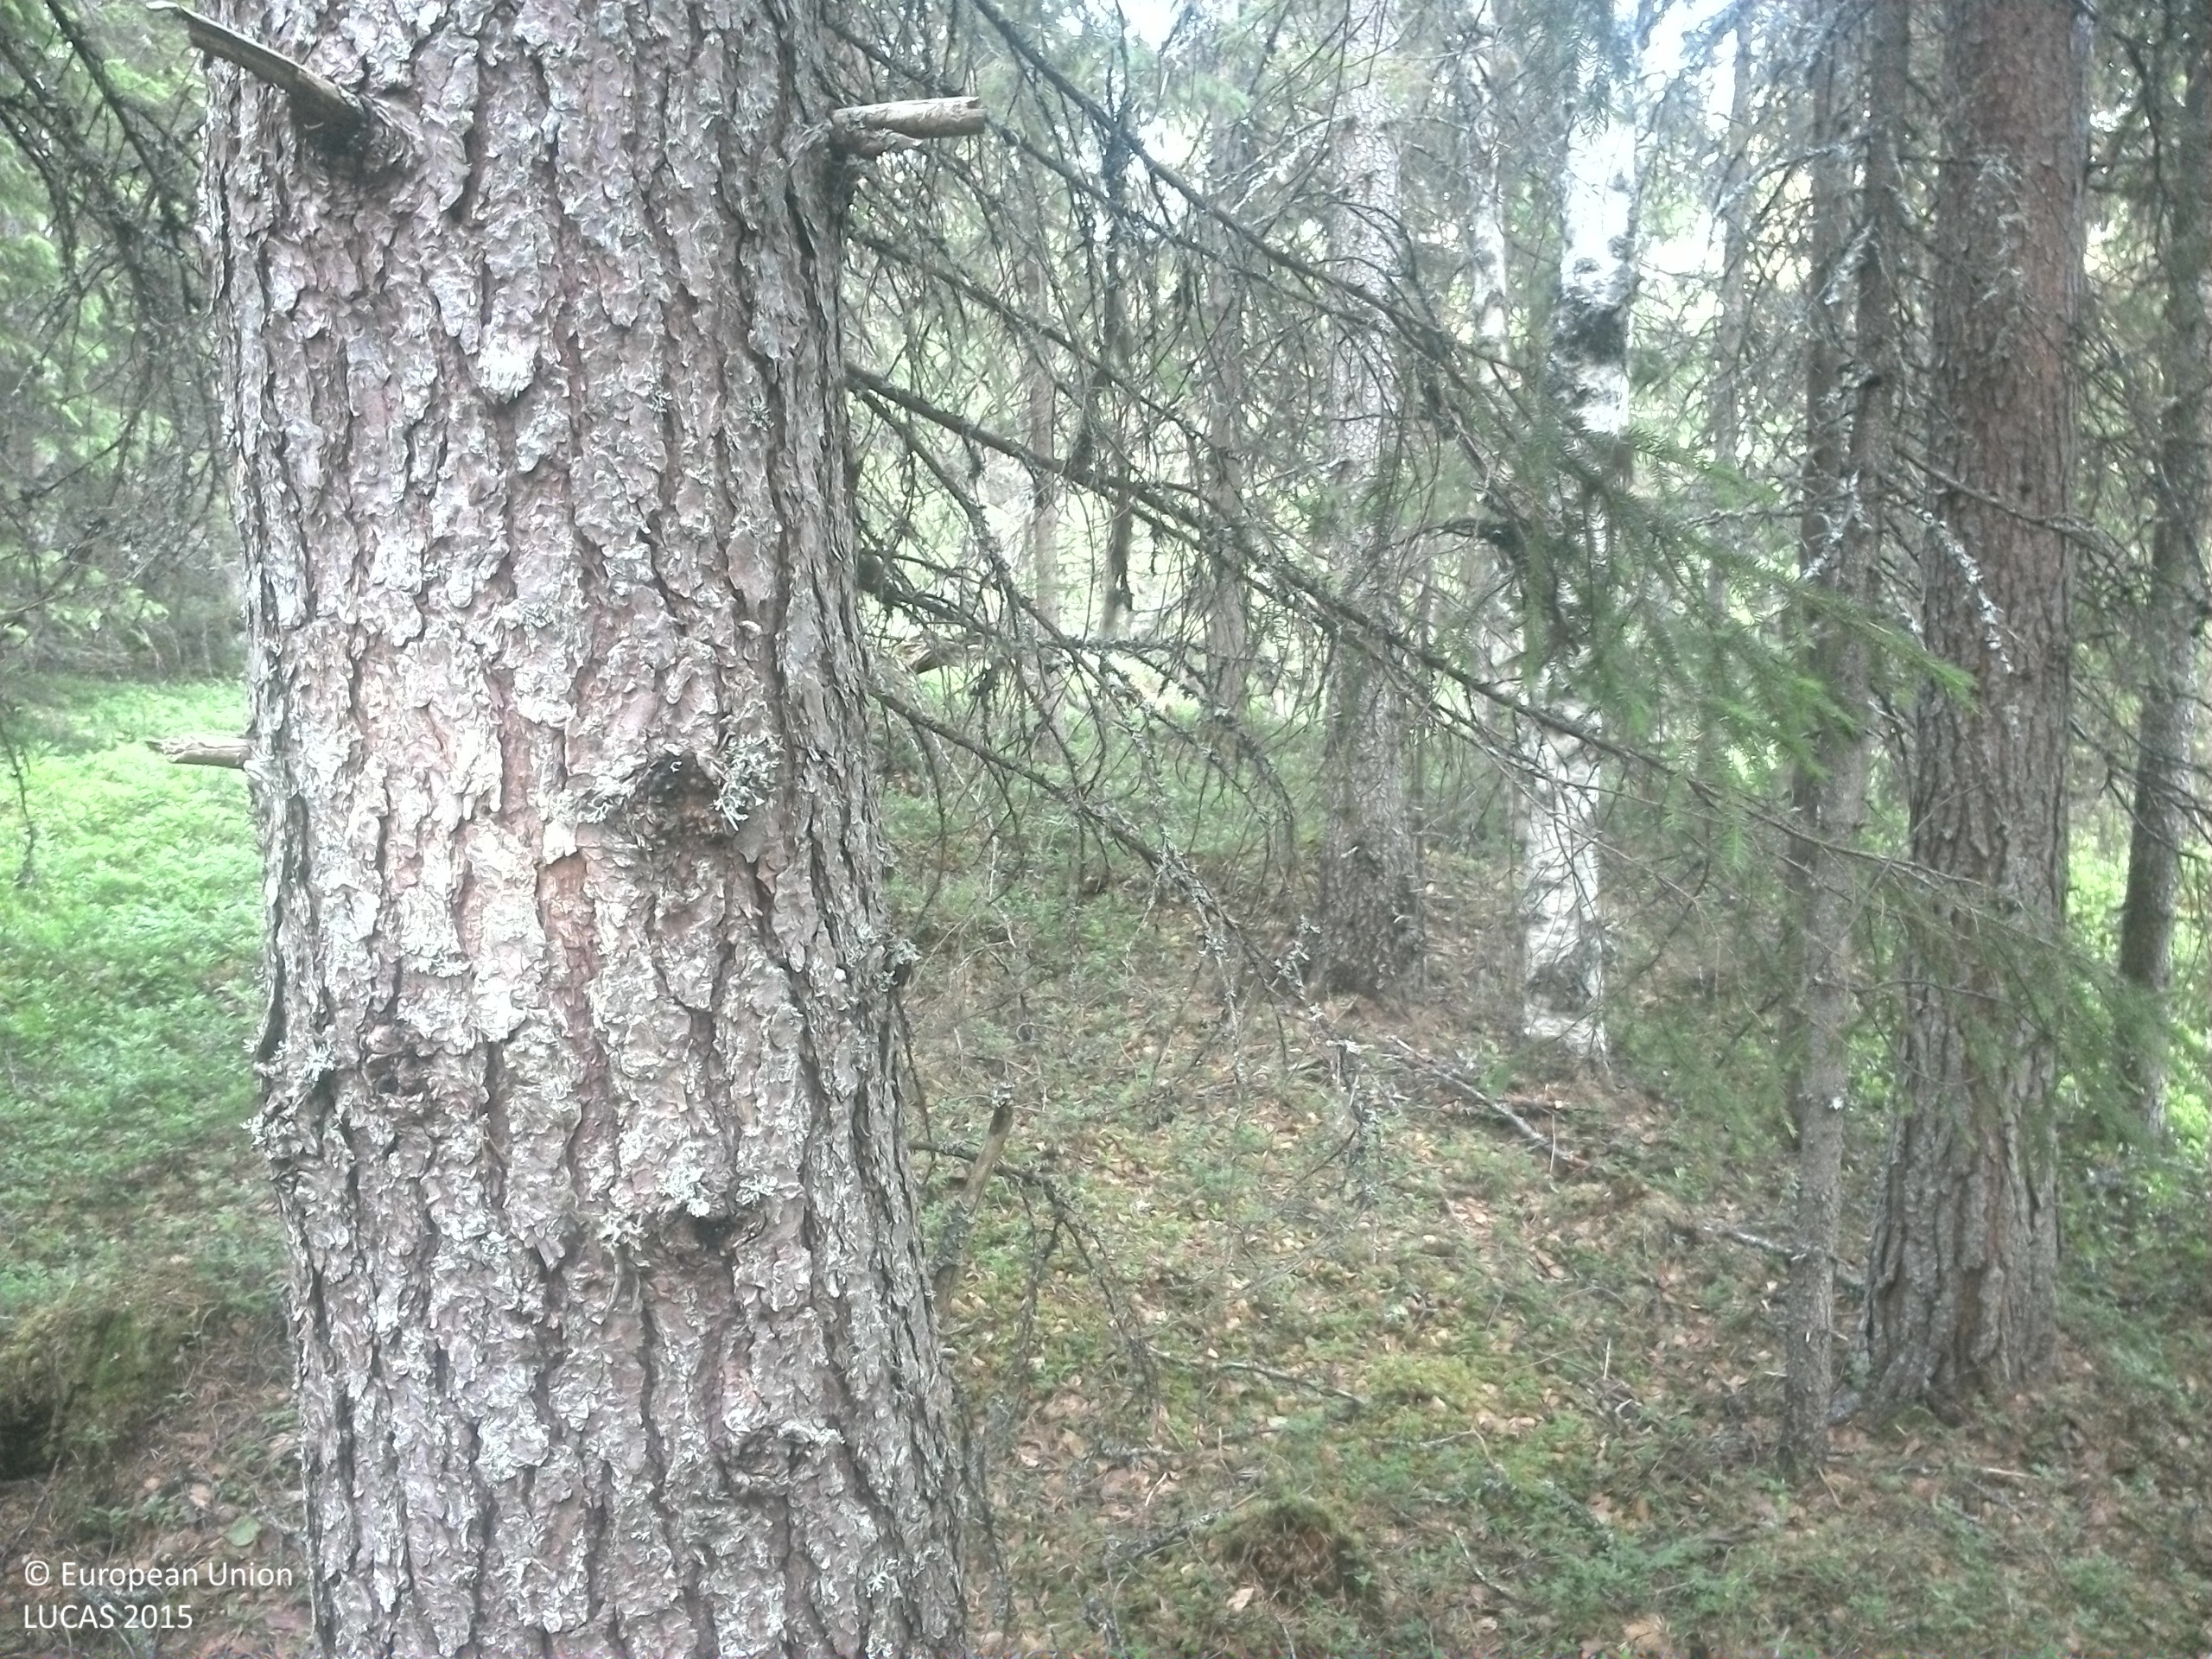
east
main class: Woodland
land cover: Spruce dominated coniferous woodland
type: boreal forest
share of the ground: > 75 %
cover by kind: coniferous forest trees 75 %, shrubs 10 %, herbaceous plants 10 %, broadleaved forest trees 5 %
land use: Forestry
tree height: > 5 m
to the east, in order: Spruce dominated coniferous woodland; Pine dominated coniferous woodland; Spruce dominated mixed woodland; Shrubland with sparse tree cover
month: July
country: SE
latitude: 64.6150
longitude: 15.8849
